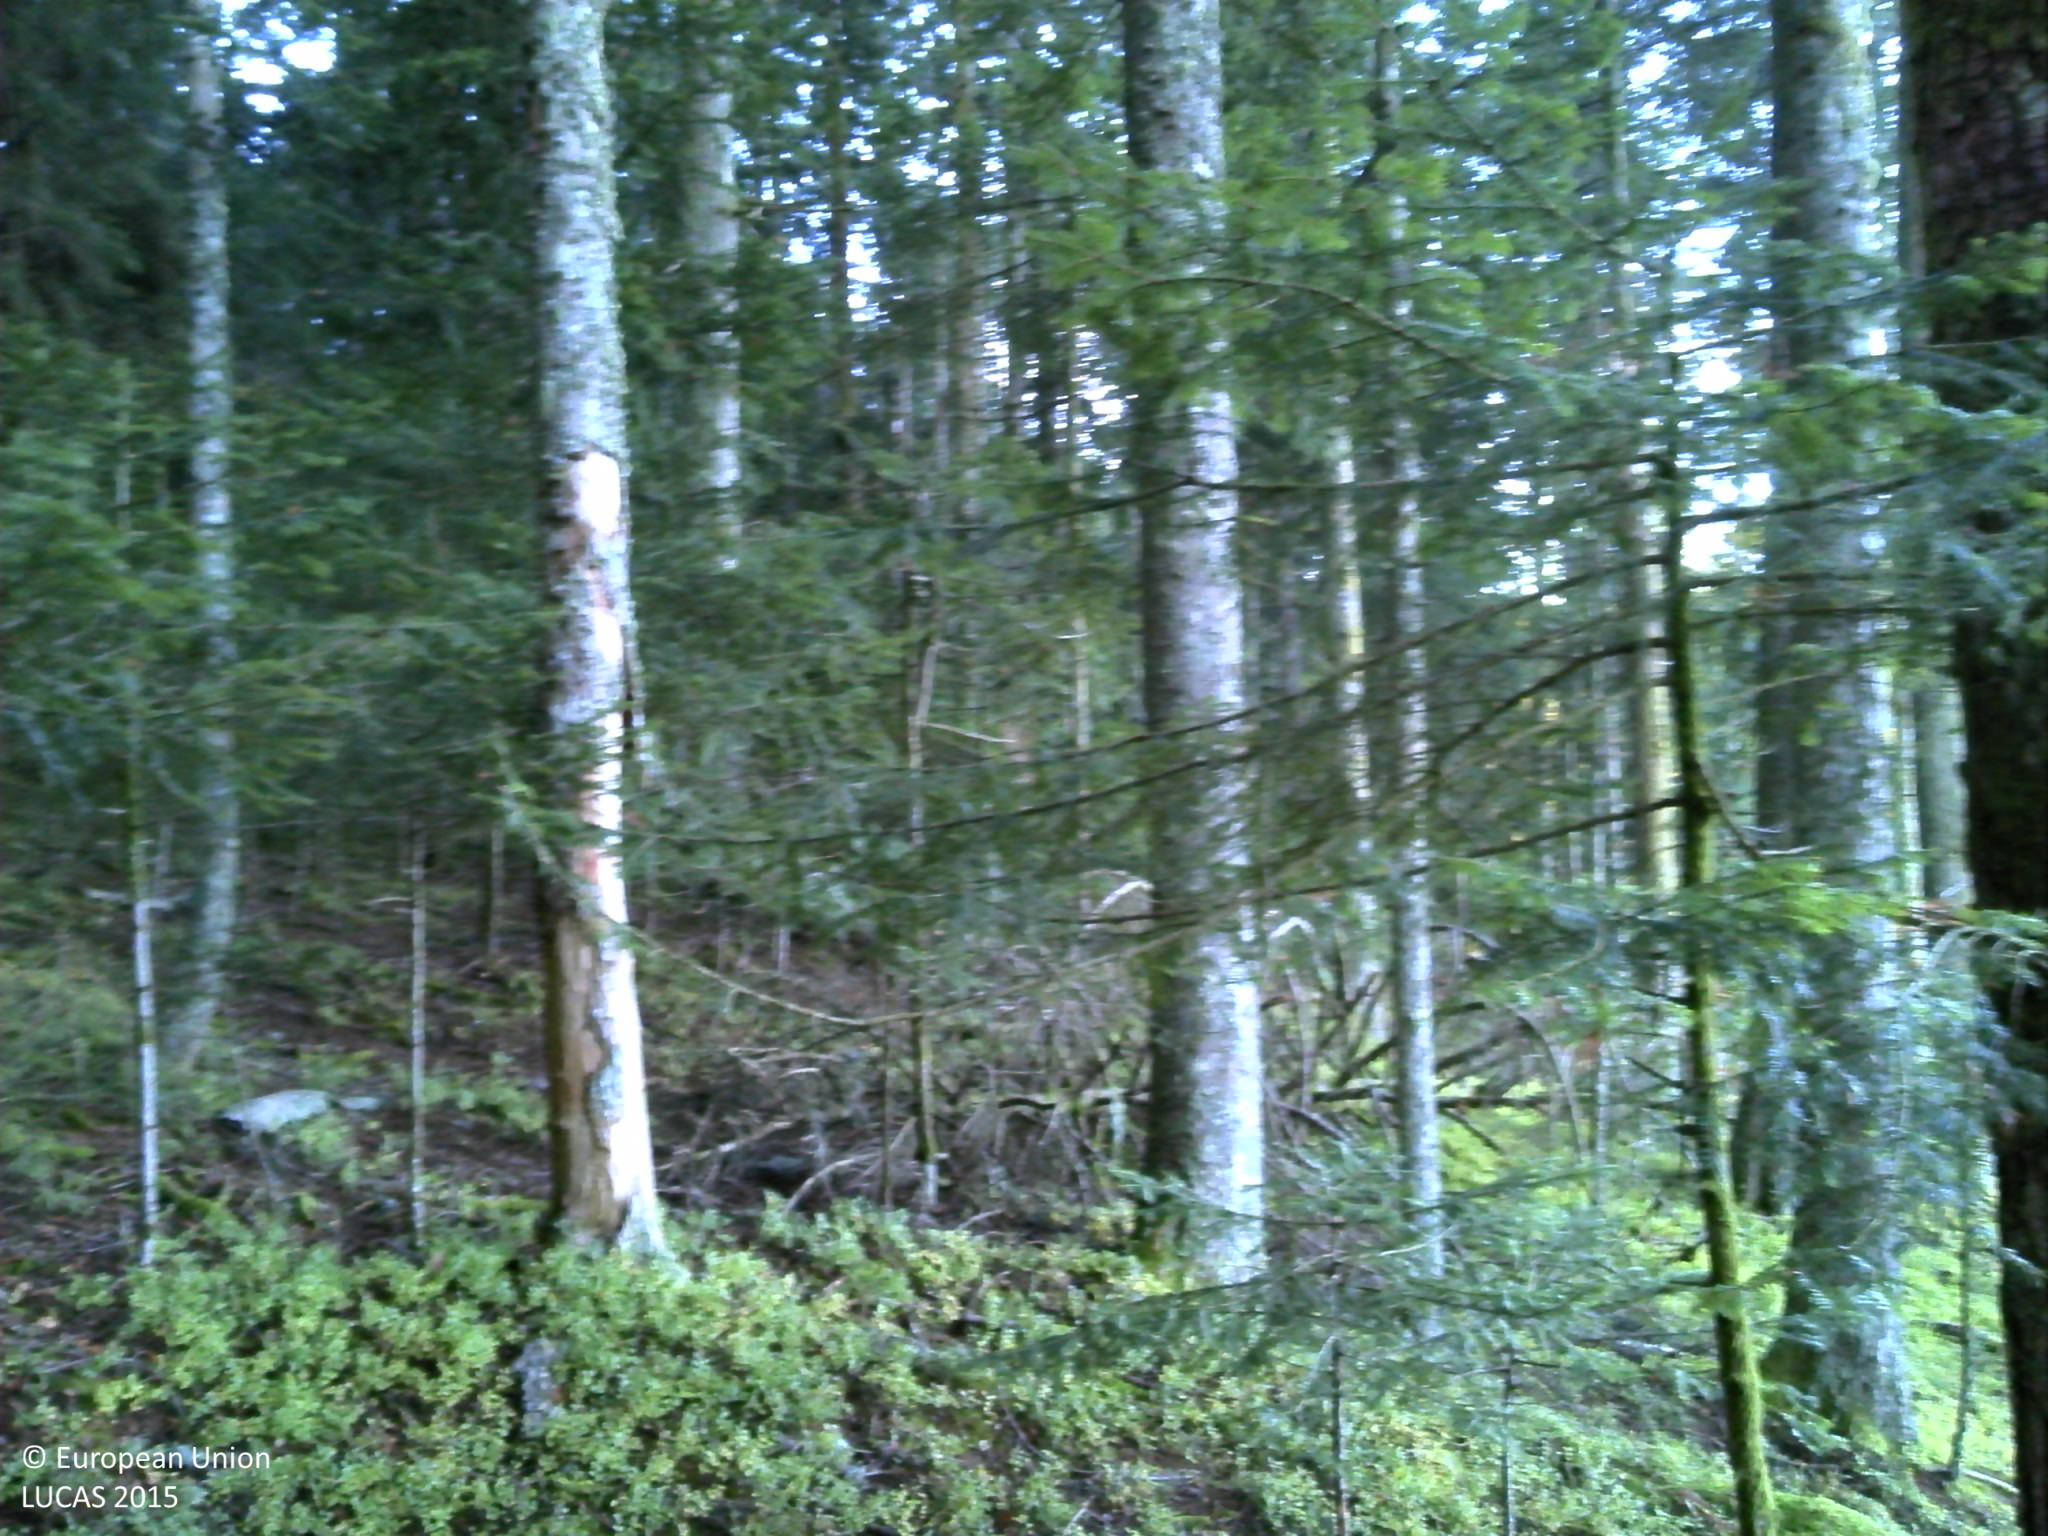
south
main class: Woodland
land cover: Other coniferous woodland
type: exotic forest
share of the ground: > 75 %
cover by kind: coniferous forest trees 85 %, broadleaved forest trees 5 %, herbaceous plants 5 %, lichens and mosses 5 %
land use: Forestry
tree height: > 5 m
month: October
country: FR
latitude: 45.7344
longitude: 3.7432
